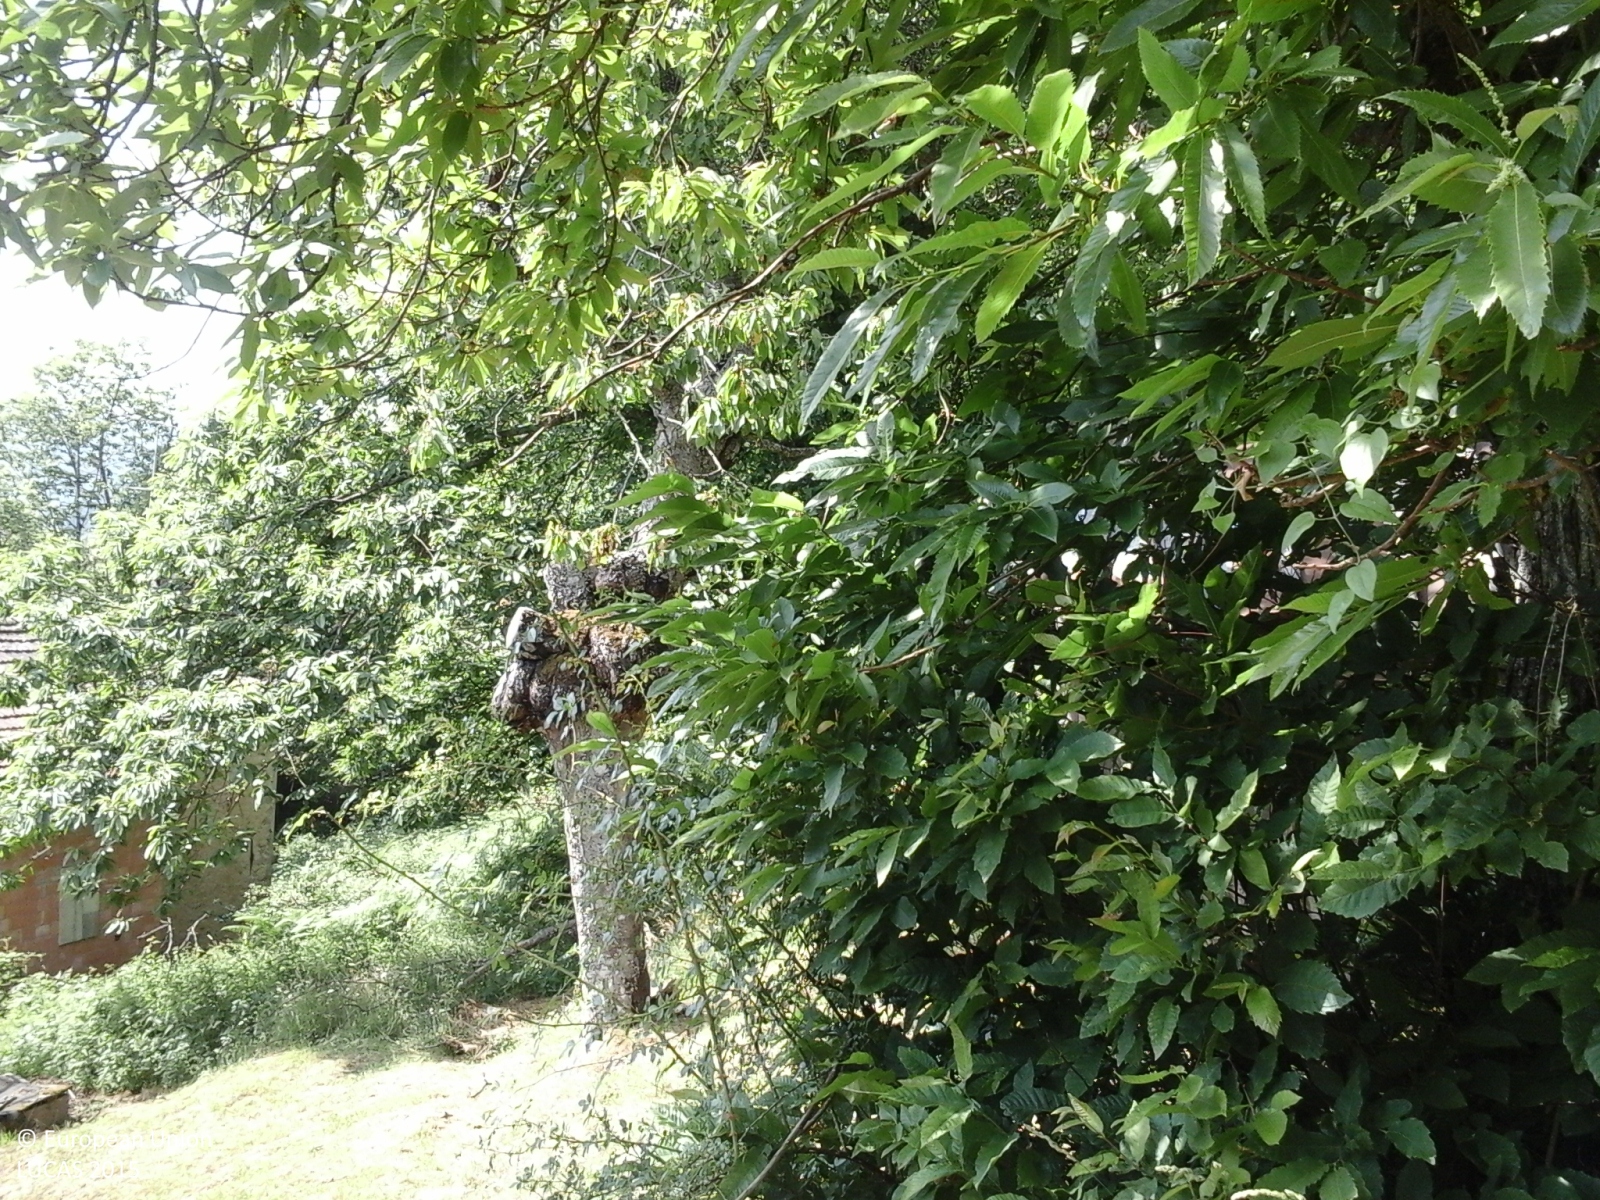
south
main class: Woodland
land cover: Broadleaved woodland
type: thermophilous deciduous forest
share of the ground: > 75 %
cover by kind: broadleaved forest trees 100 %
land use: Forestry
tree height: > 5 m
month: June
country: IT
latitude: 44.0928
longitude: 11.0342
